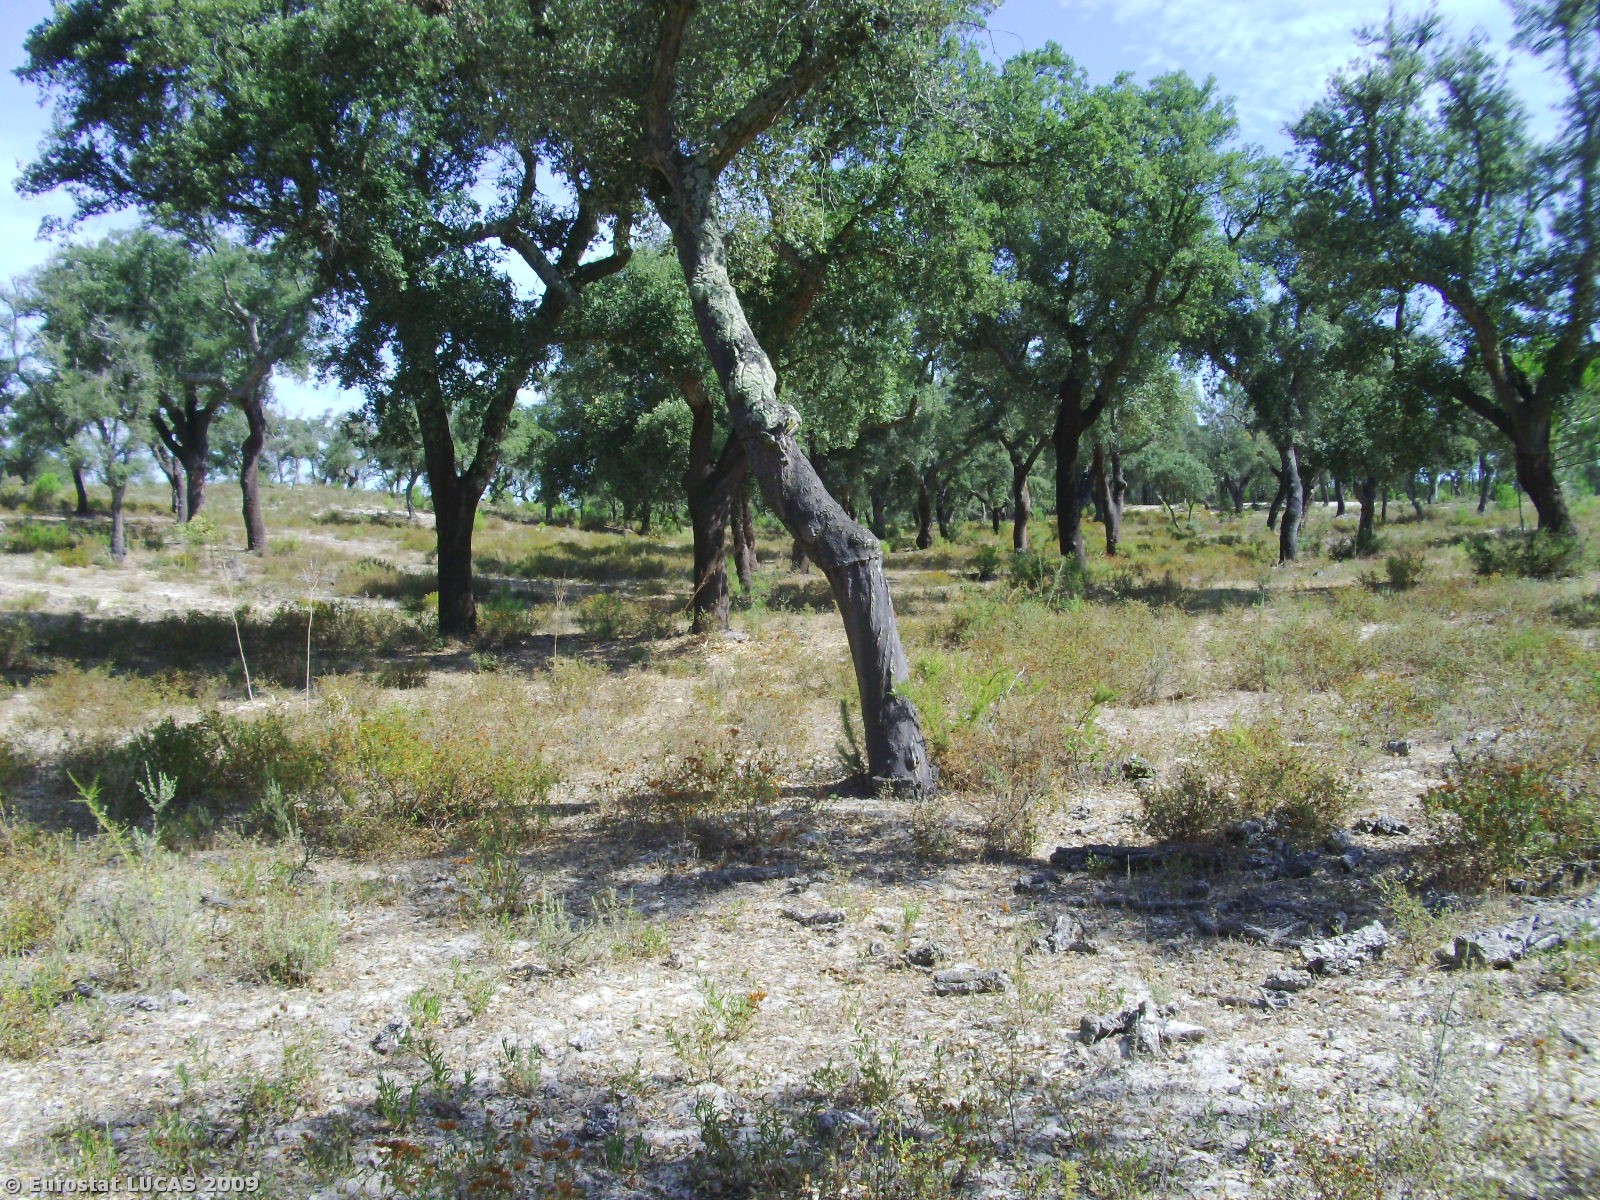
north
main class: Woodland
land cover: Broadleaved woodland
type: broadleaved evergreen forest
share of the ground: 25 - 50 %
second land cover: Spontaneously vegetated surfaces
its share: 50 - 75 %
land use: Forestry
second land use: Fallow land
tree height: > 5 m
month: August
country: PT
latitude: 38.5694
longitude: -8.6637
